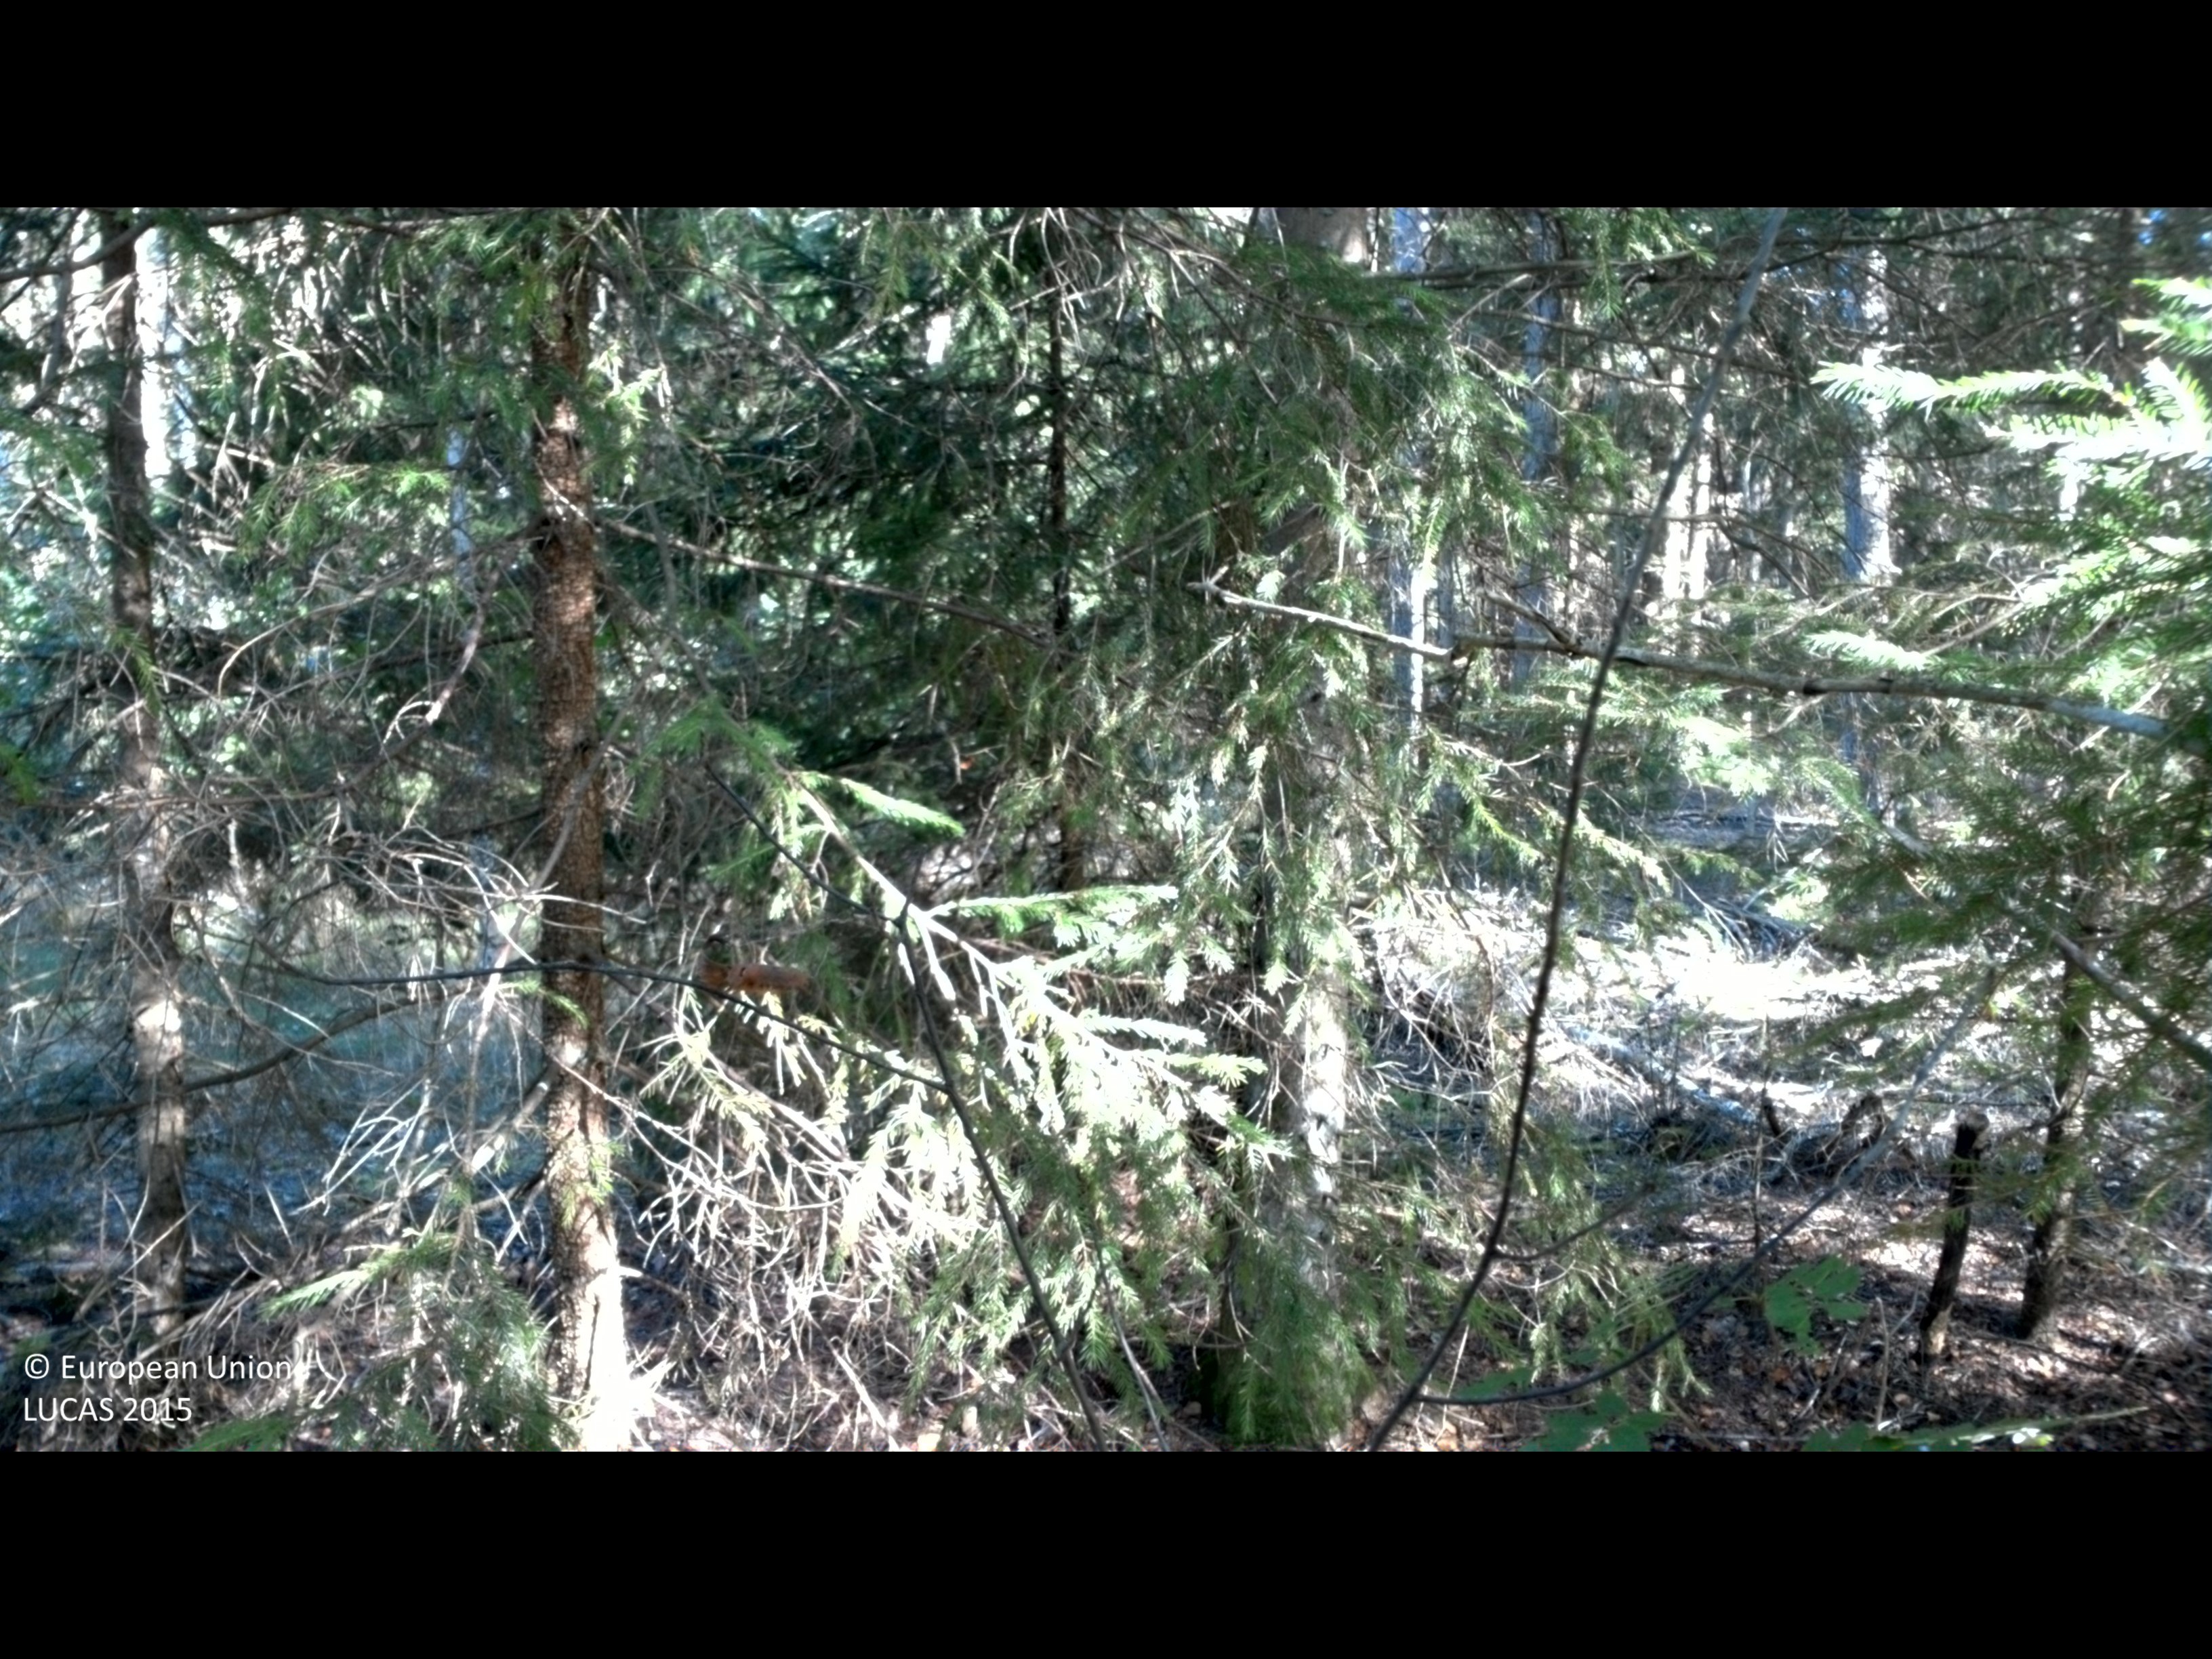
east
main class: Woodland
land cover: Spruce dominated mixed woodland
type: hemiboreal forest and nemoral coniferous forest and mixed broadleaved-coniferous forest
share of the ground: > 75 %
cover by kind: coniferous forest trees 55 %, broadleaved forest trees 20 %, shrubs 5 %, herbaceous plants 5 %, consolidated bare surface 5 %
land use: Forestry
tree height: > 5 m
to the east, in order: Spruce dominated mixed woodland; Paved roads, cycling and walking lanes; Groves; Spruce dominated coniferous woodland; Ditches and canals; Spruce dominated coniferous woodland; Dry stone walls; Spruce dominated coniferous woodland; Ditches and canals; Spruce dominated coniferous woodland
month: August
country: SE
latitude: 56.2438
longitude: 14.2416
